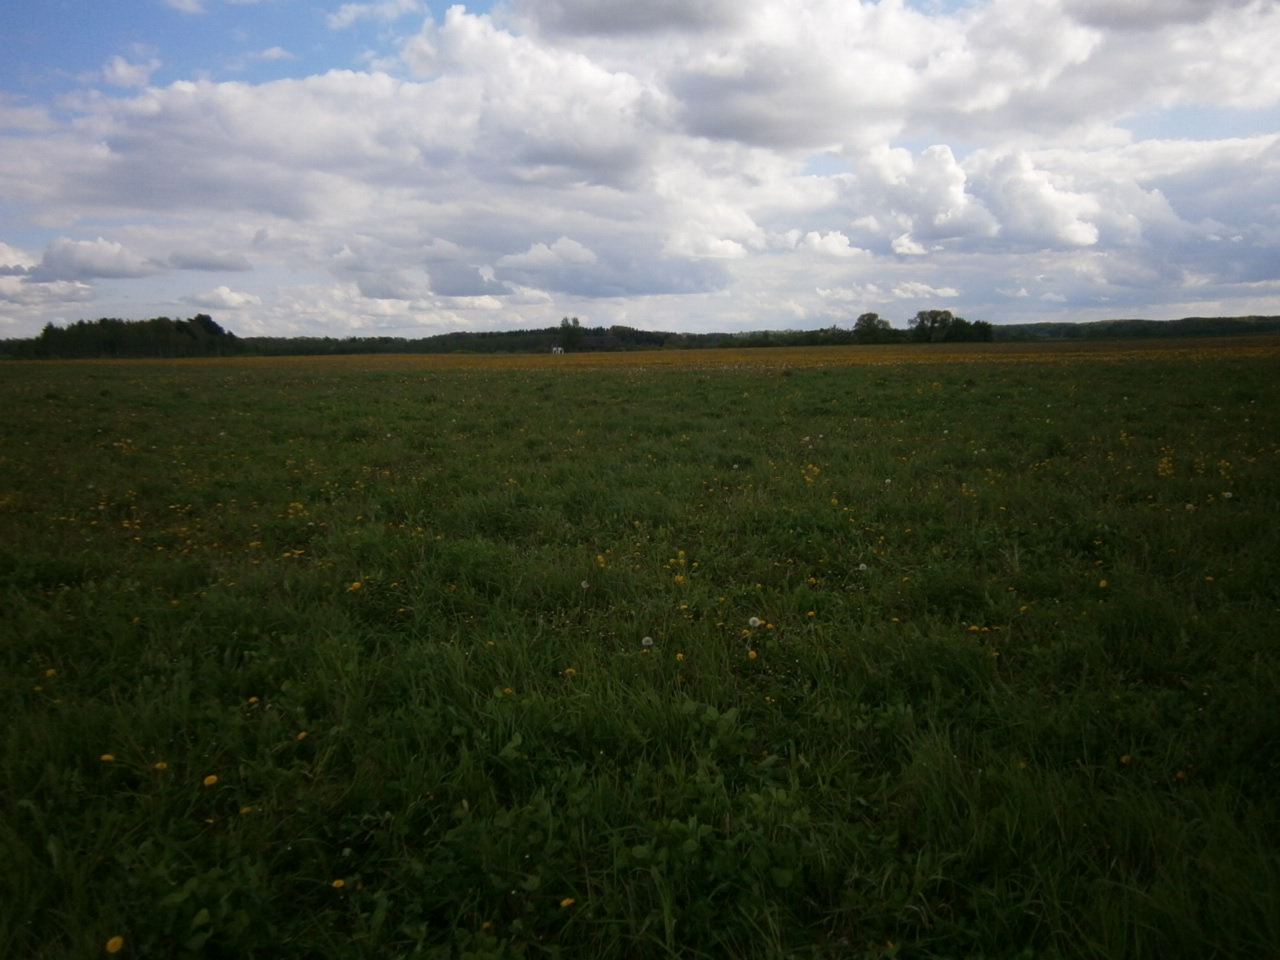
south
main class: Grassland
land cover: Grassland without tree/shrub cover
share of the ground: > 75 %
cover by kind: herbaceous plants 100 %
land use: Agriculture (excluding fallow land and kitchen gardens)
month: May
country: LV
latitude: 56.6433
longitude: 22.3662
